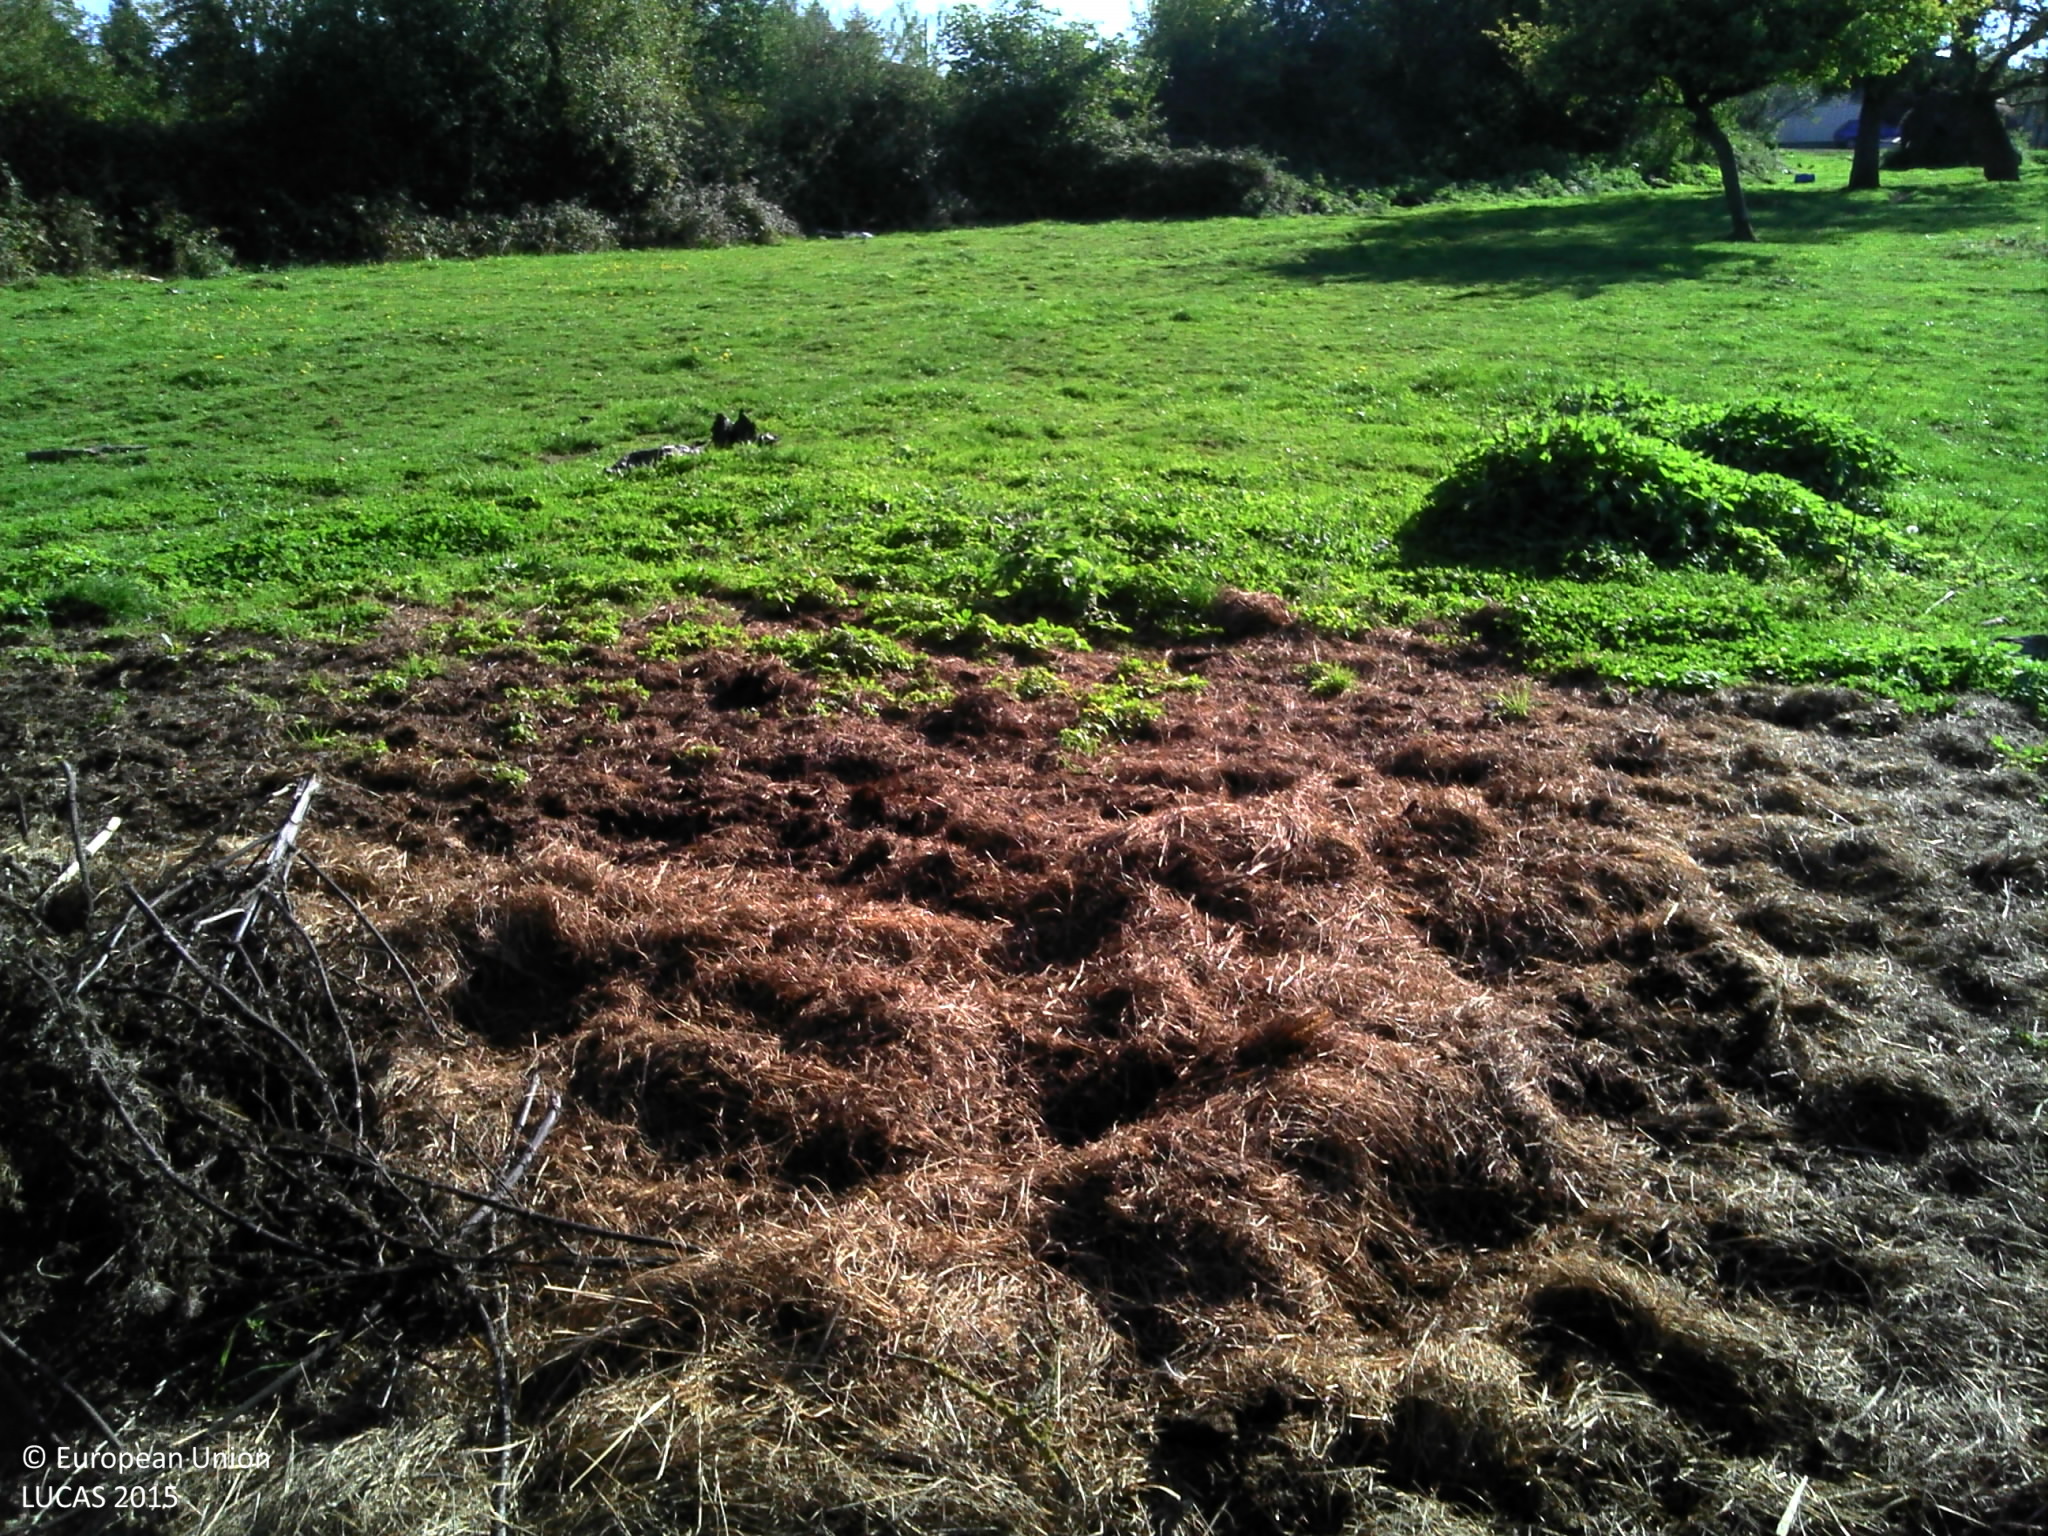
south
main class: Grassland
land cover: Grassland with sparse tree/shrub cover
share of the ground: > 75 %
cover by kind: herbaceous plants 95 %, broadleaved forest trees 5 %
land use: Agriculture (excluding fallow land and kitchen gardens)
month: September
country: FR
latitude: 48.0721
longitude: 3.8895
